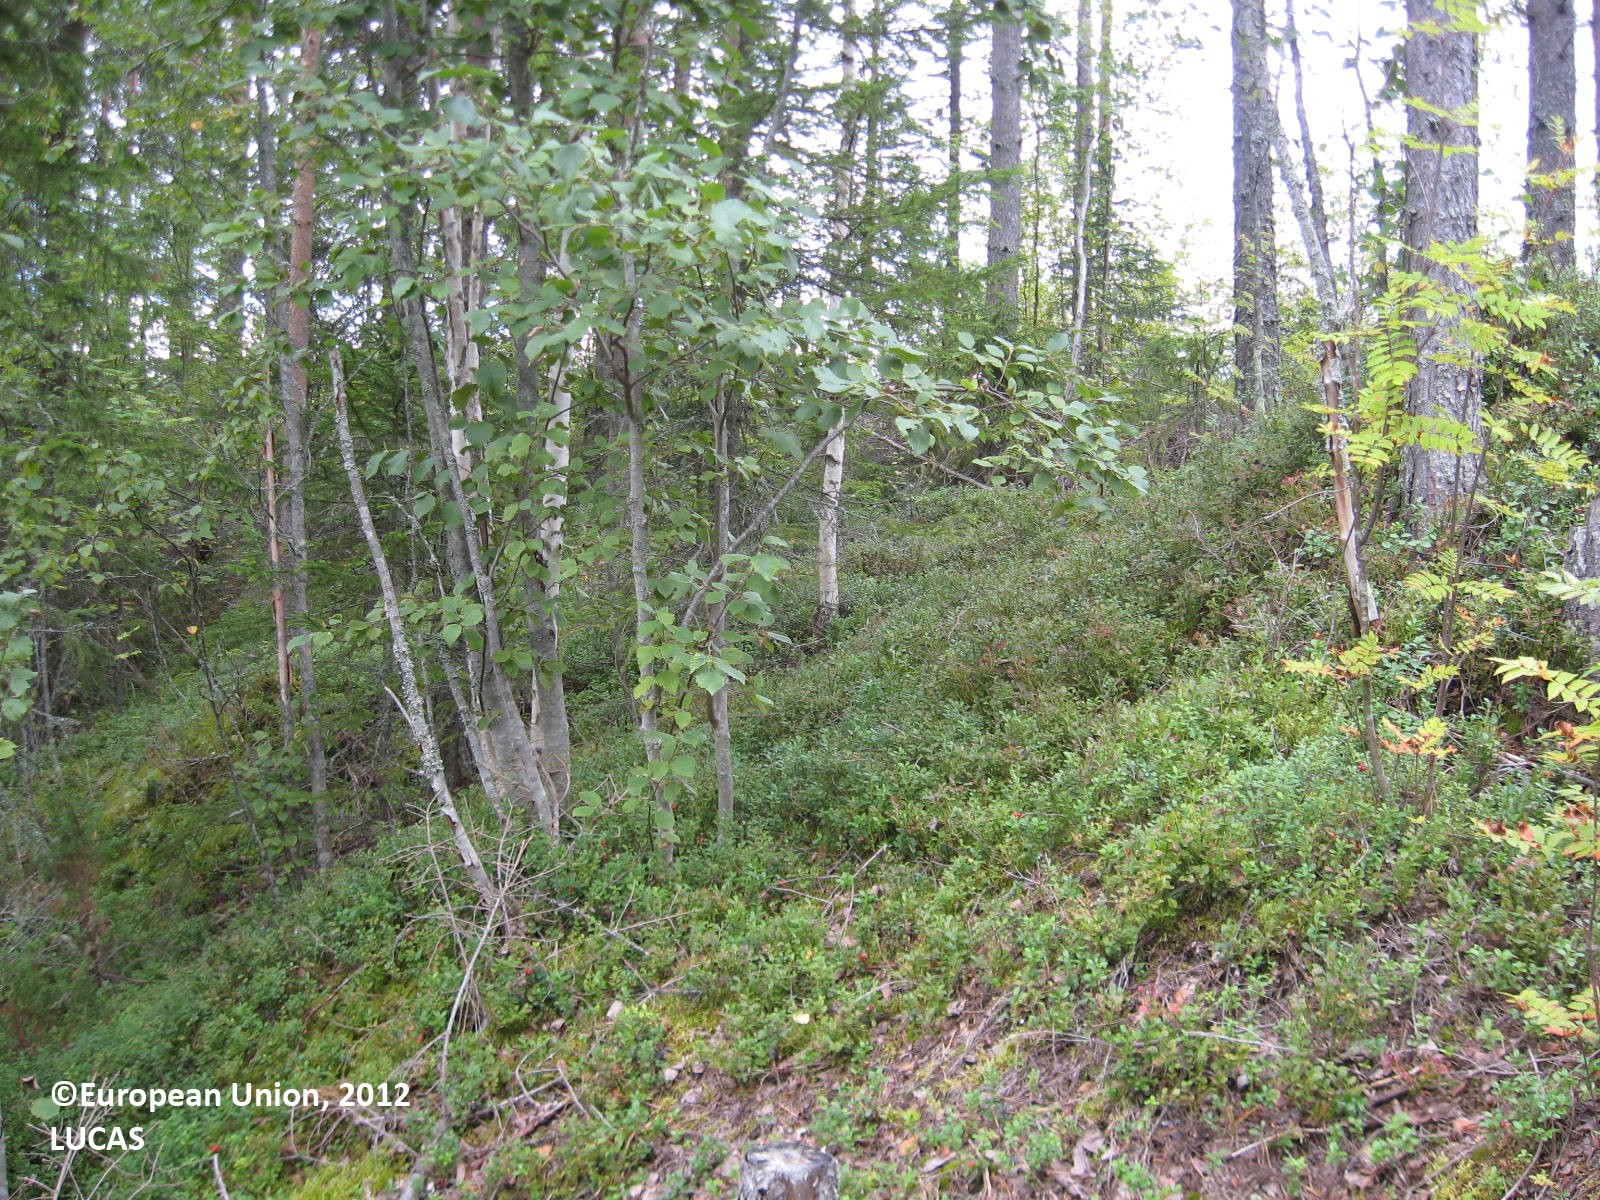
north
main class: Woodland
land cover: Pine dominated mixed woodland
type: boreal forest
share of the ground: 50 - 75 %
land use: Forestry
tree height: > 5 m
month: August
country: FI
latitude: 63.6827
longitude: 29.2808
